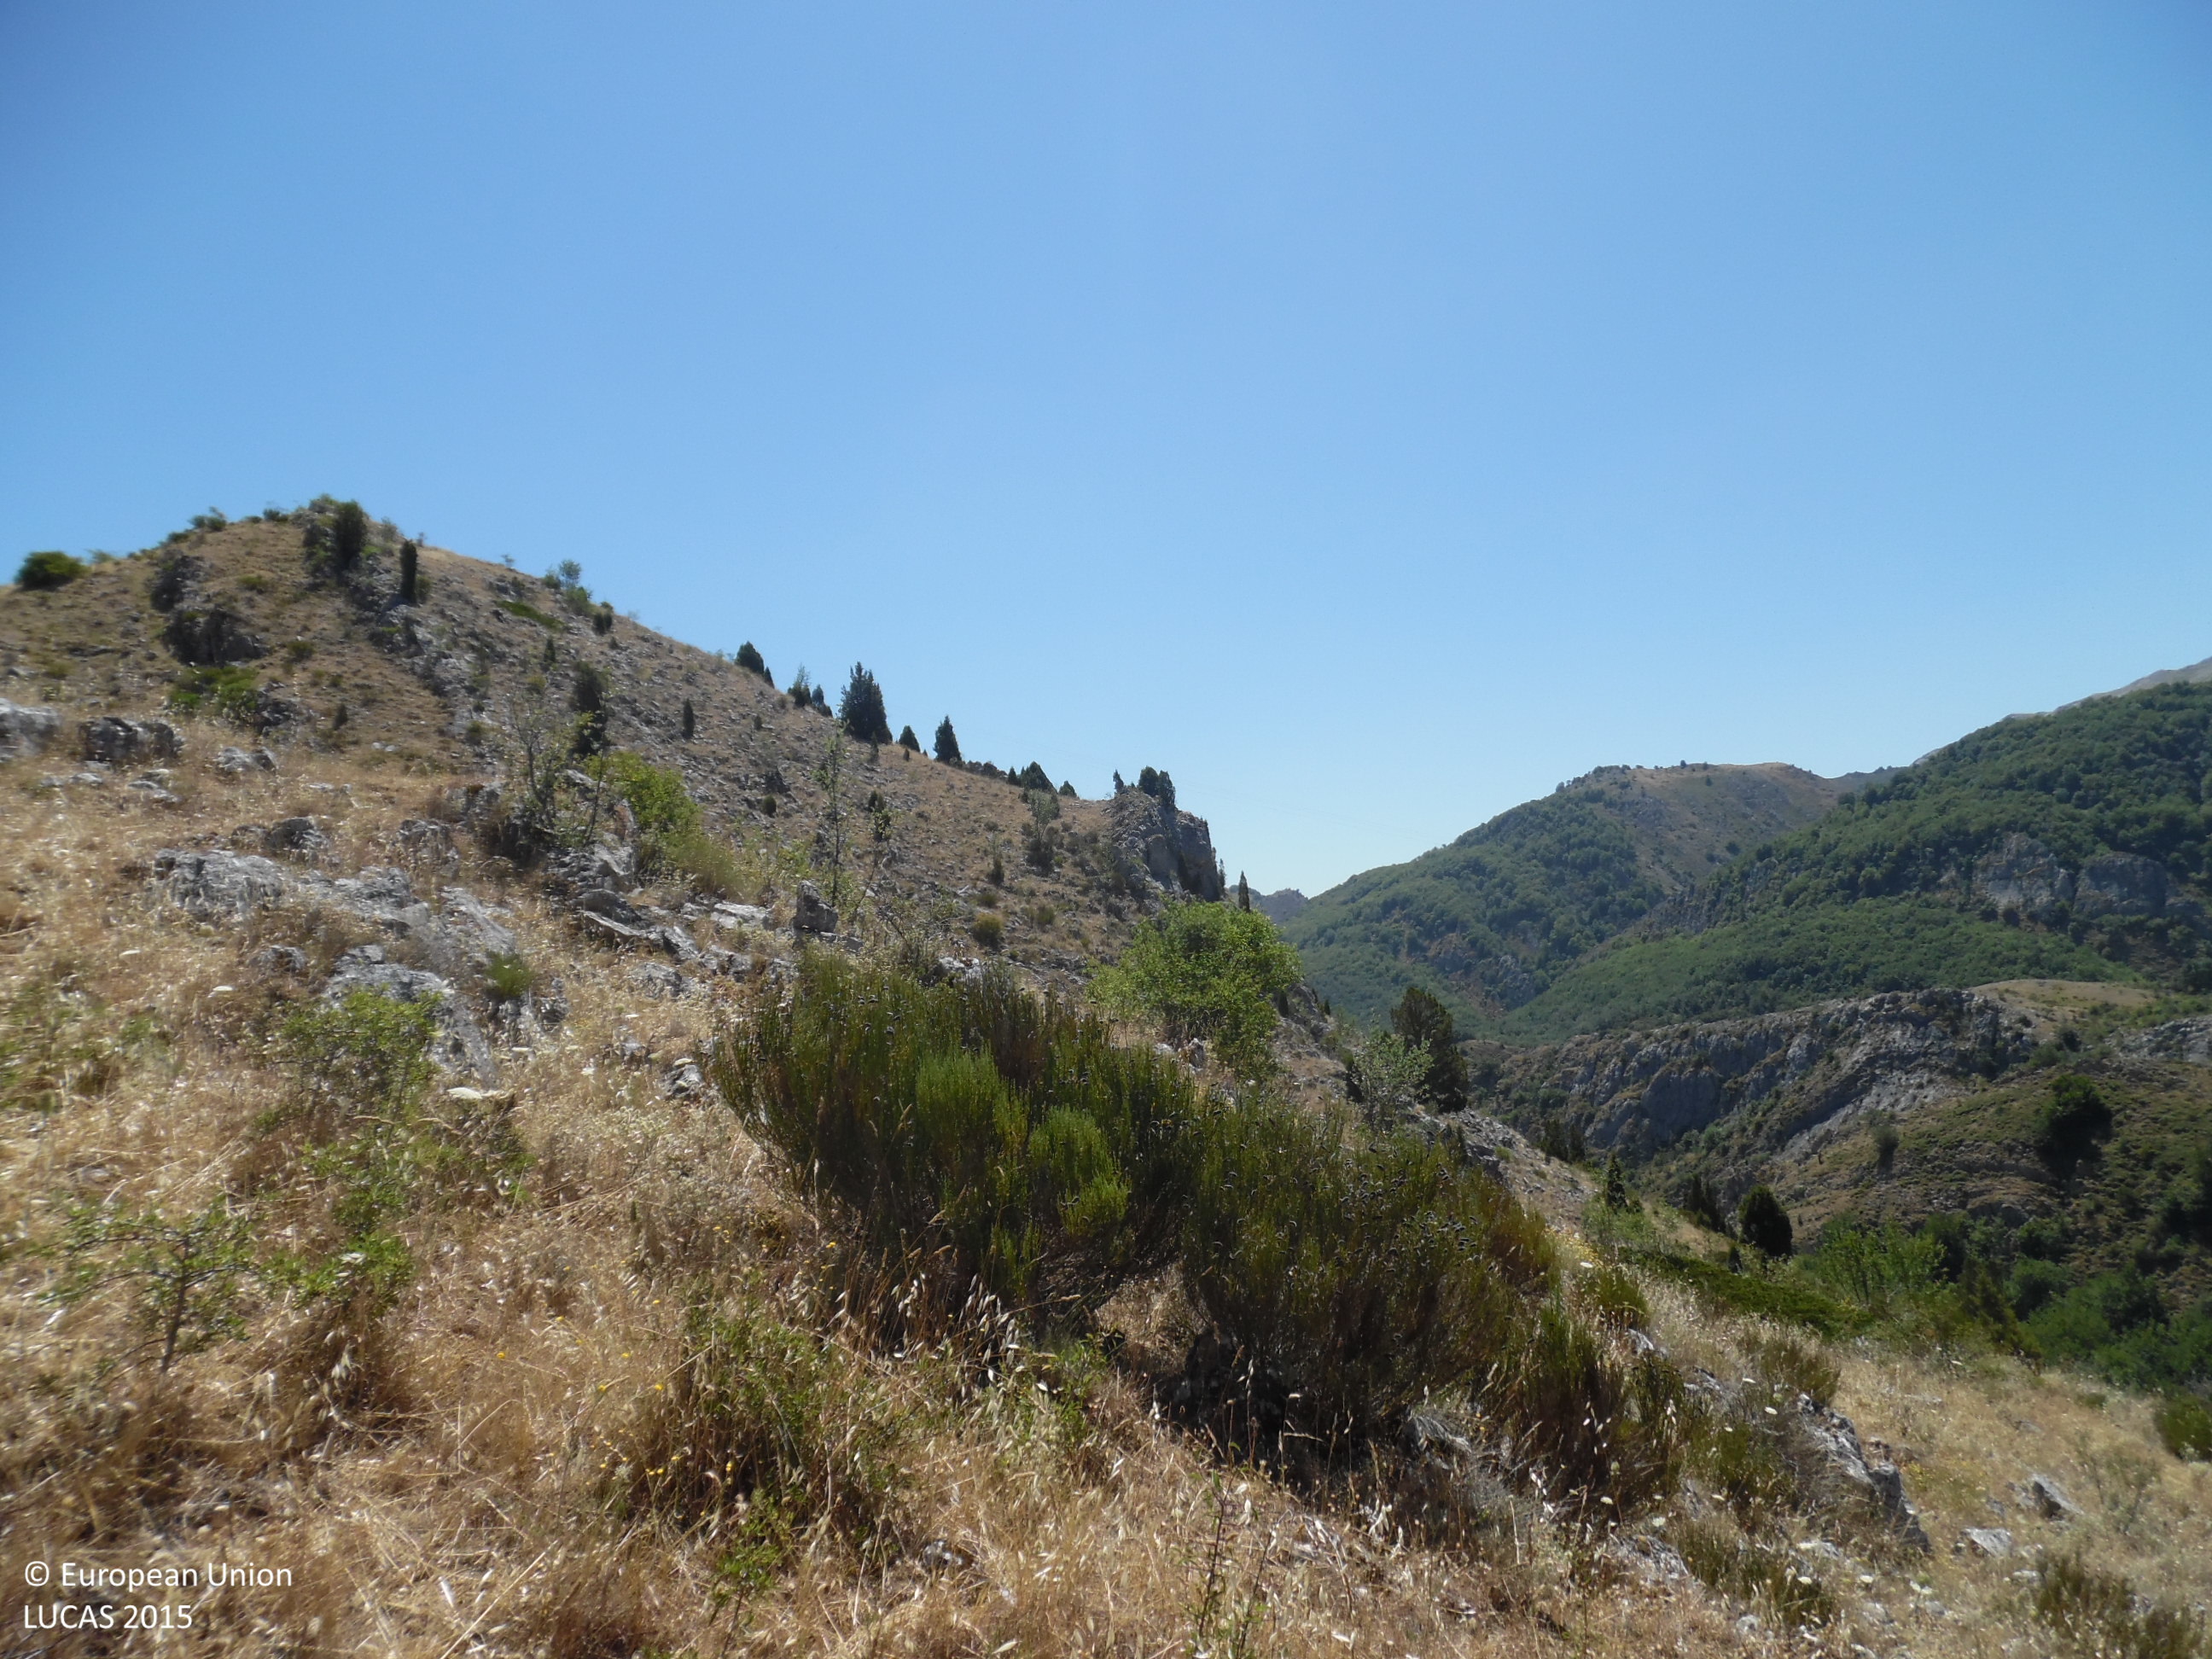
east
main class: Grassland
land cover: Grassland with sparse tree/shrub cover
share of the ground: > 75 %
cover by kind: herbaceous plants 90 %, broadleaved forest trees 5 %, shrubs 5 %
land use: Agriculture (excluding fallow land and kitchen gardens)
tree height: < 5 m
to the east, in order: Grassland with sparse tree/shrub cover; Rocks and stones; Grassland with sparse tree/shrub cover; Grassland without tree/shrub cover; Grassland with sparse tree/shrub cover; Dry stone walls; Rocks and stones; Shrubland with sparse tree cover; Grassland with sparse tree/shrub cover; Dry stone walls; Tracks; Fences; Single bushes/trees; Dry stone walls; Grassland without tree/shrub cover; Dry stone walls; Fences; Other fresh vegetables; Abandoned hedges; Fences; Electric lines; Artificial constructions in urban areas
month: July
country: ES
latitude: 42.8834
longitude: -5.7393
